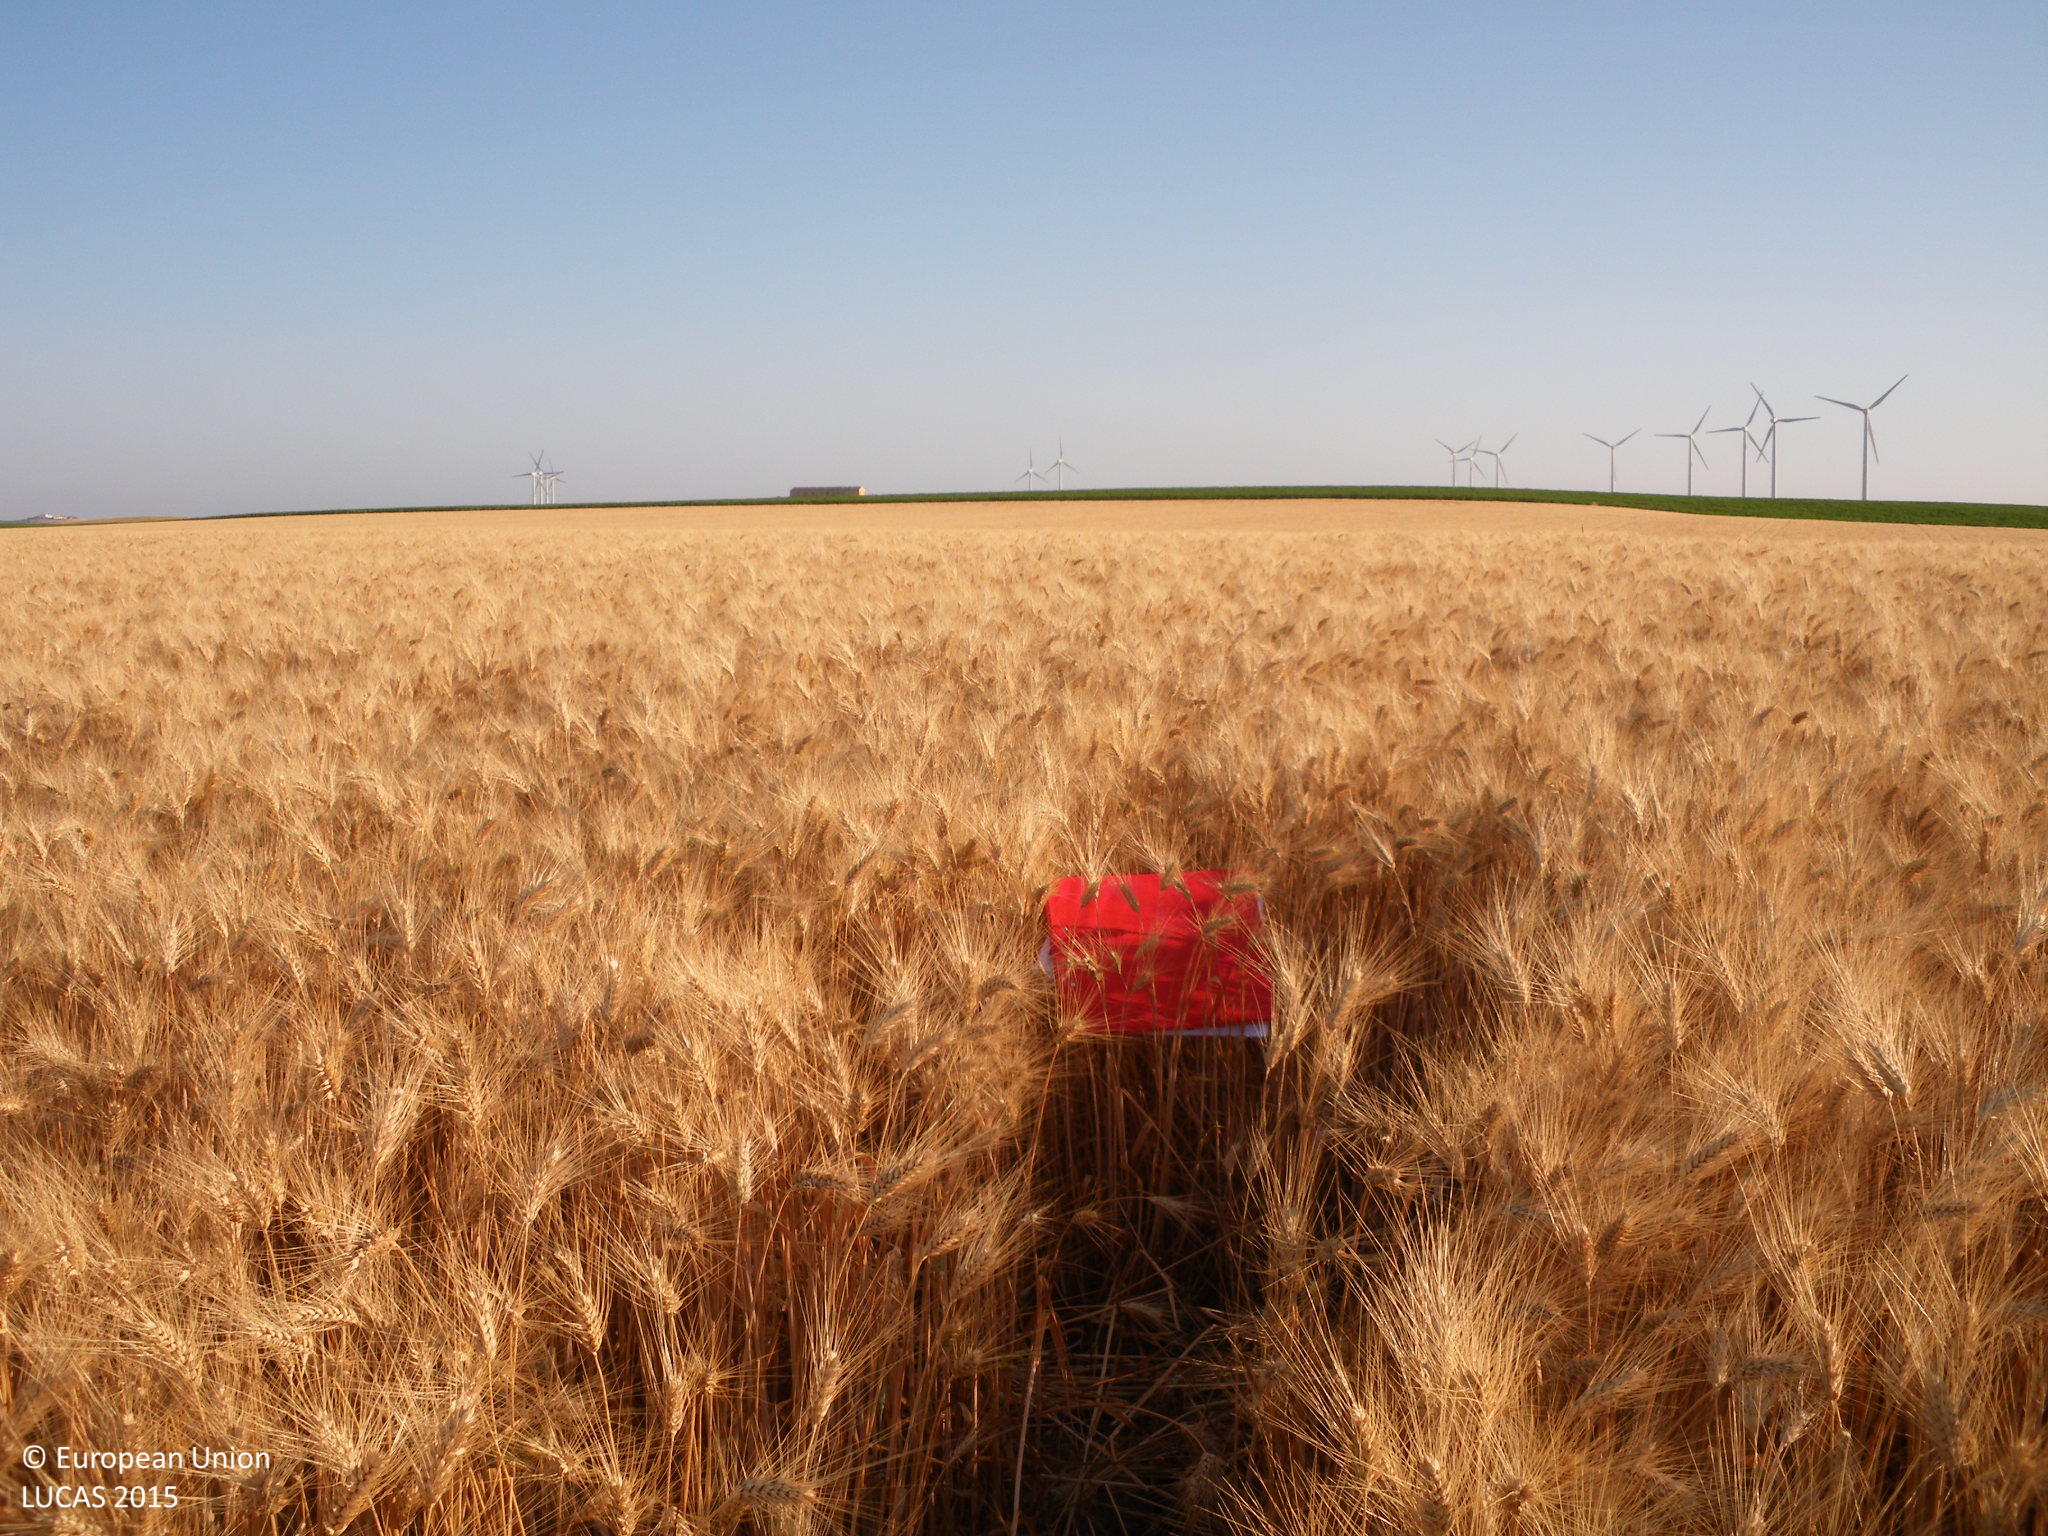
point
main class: Cropland
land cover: Durum wheat
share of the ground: > 75 %
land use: Agriculture (excluding fallow land and kitchen gardens)
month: May
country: ES
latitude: 36.7606
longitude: -6.2700
